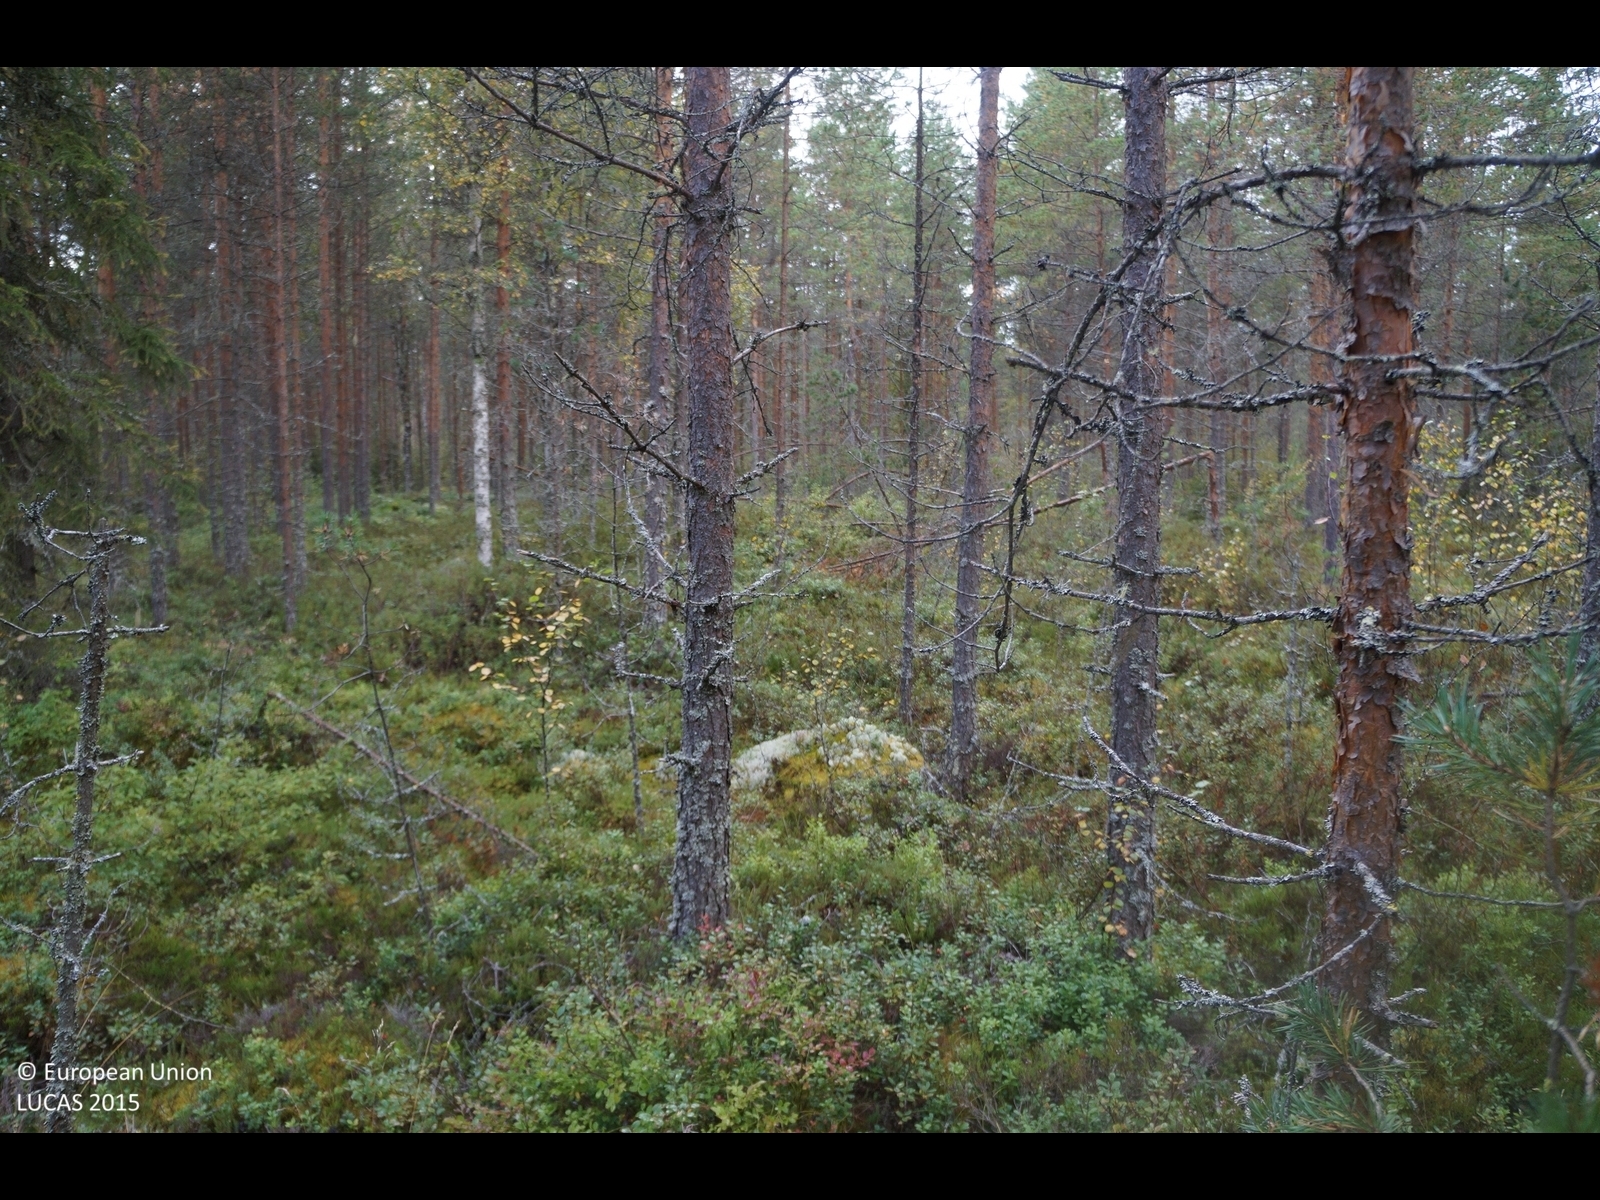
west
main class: Woodland
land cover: Pine dominated coniferous woodland
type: boreal forest
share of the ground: 50 - 75 %
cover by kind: coniferous forest trees 60 %, shrubs 20 %, lichens and mosses 15 %, herbaceous plants 5 %
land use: Forestry
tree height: > 5 m
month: September
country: FI
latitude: 63.8713
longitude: 24.3399
